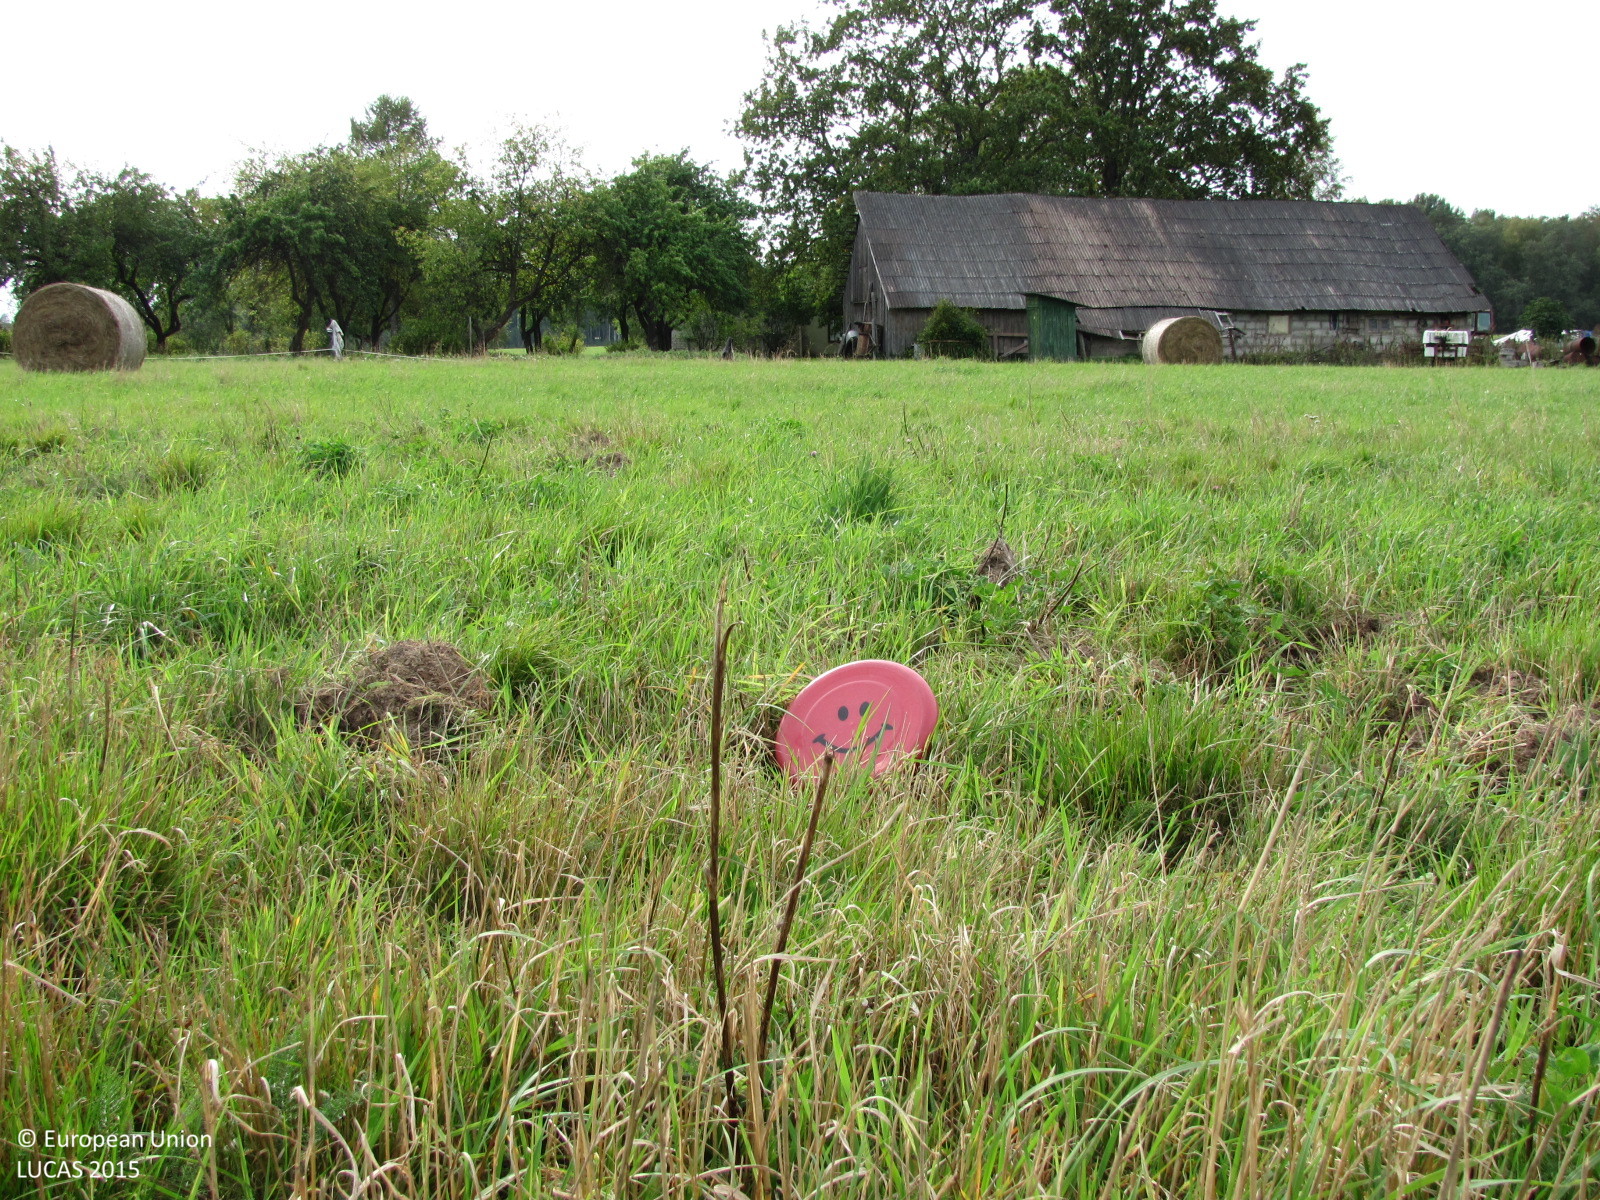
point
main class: Grassland
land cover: Grassland without tree/shrub cover
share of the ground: > 75 %
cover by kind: herbaceous plants 100 %
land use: Agriculture (excluding fallow land and kitchen gardens)
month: September
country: LV
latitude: 57.1600
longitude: 24.5950
